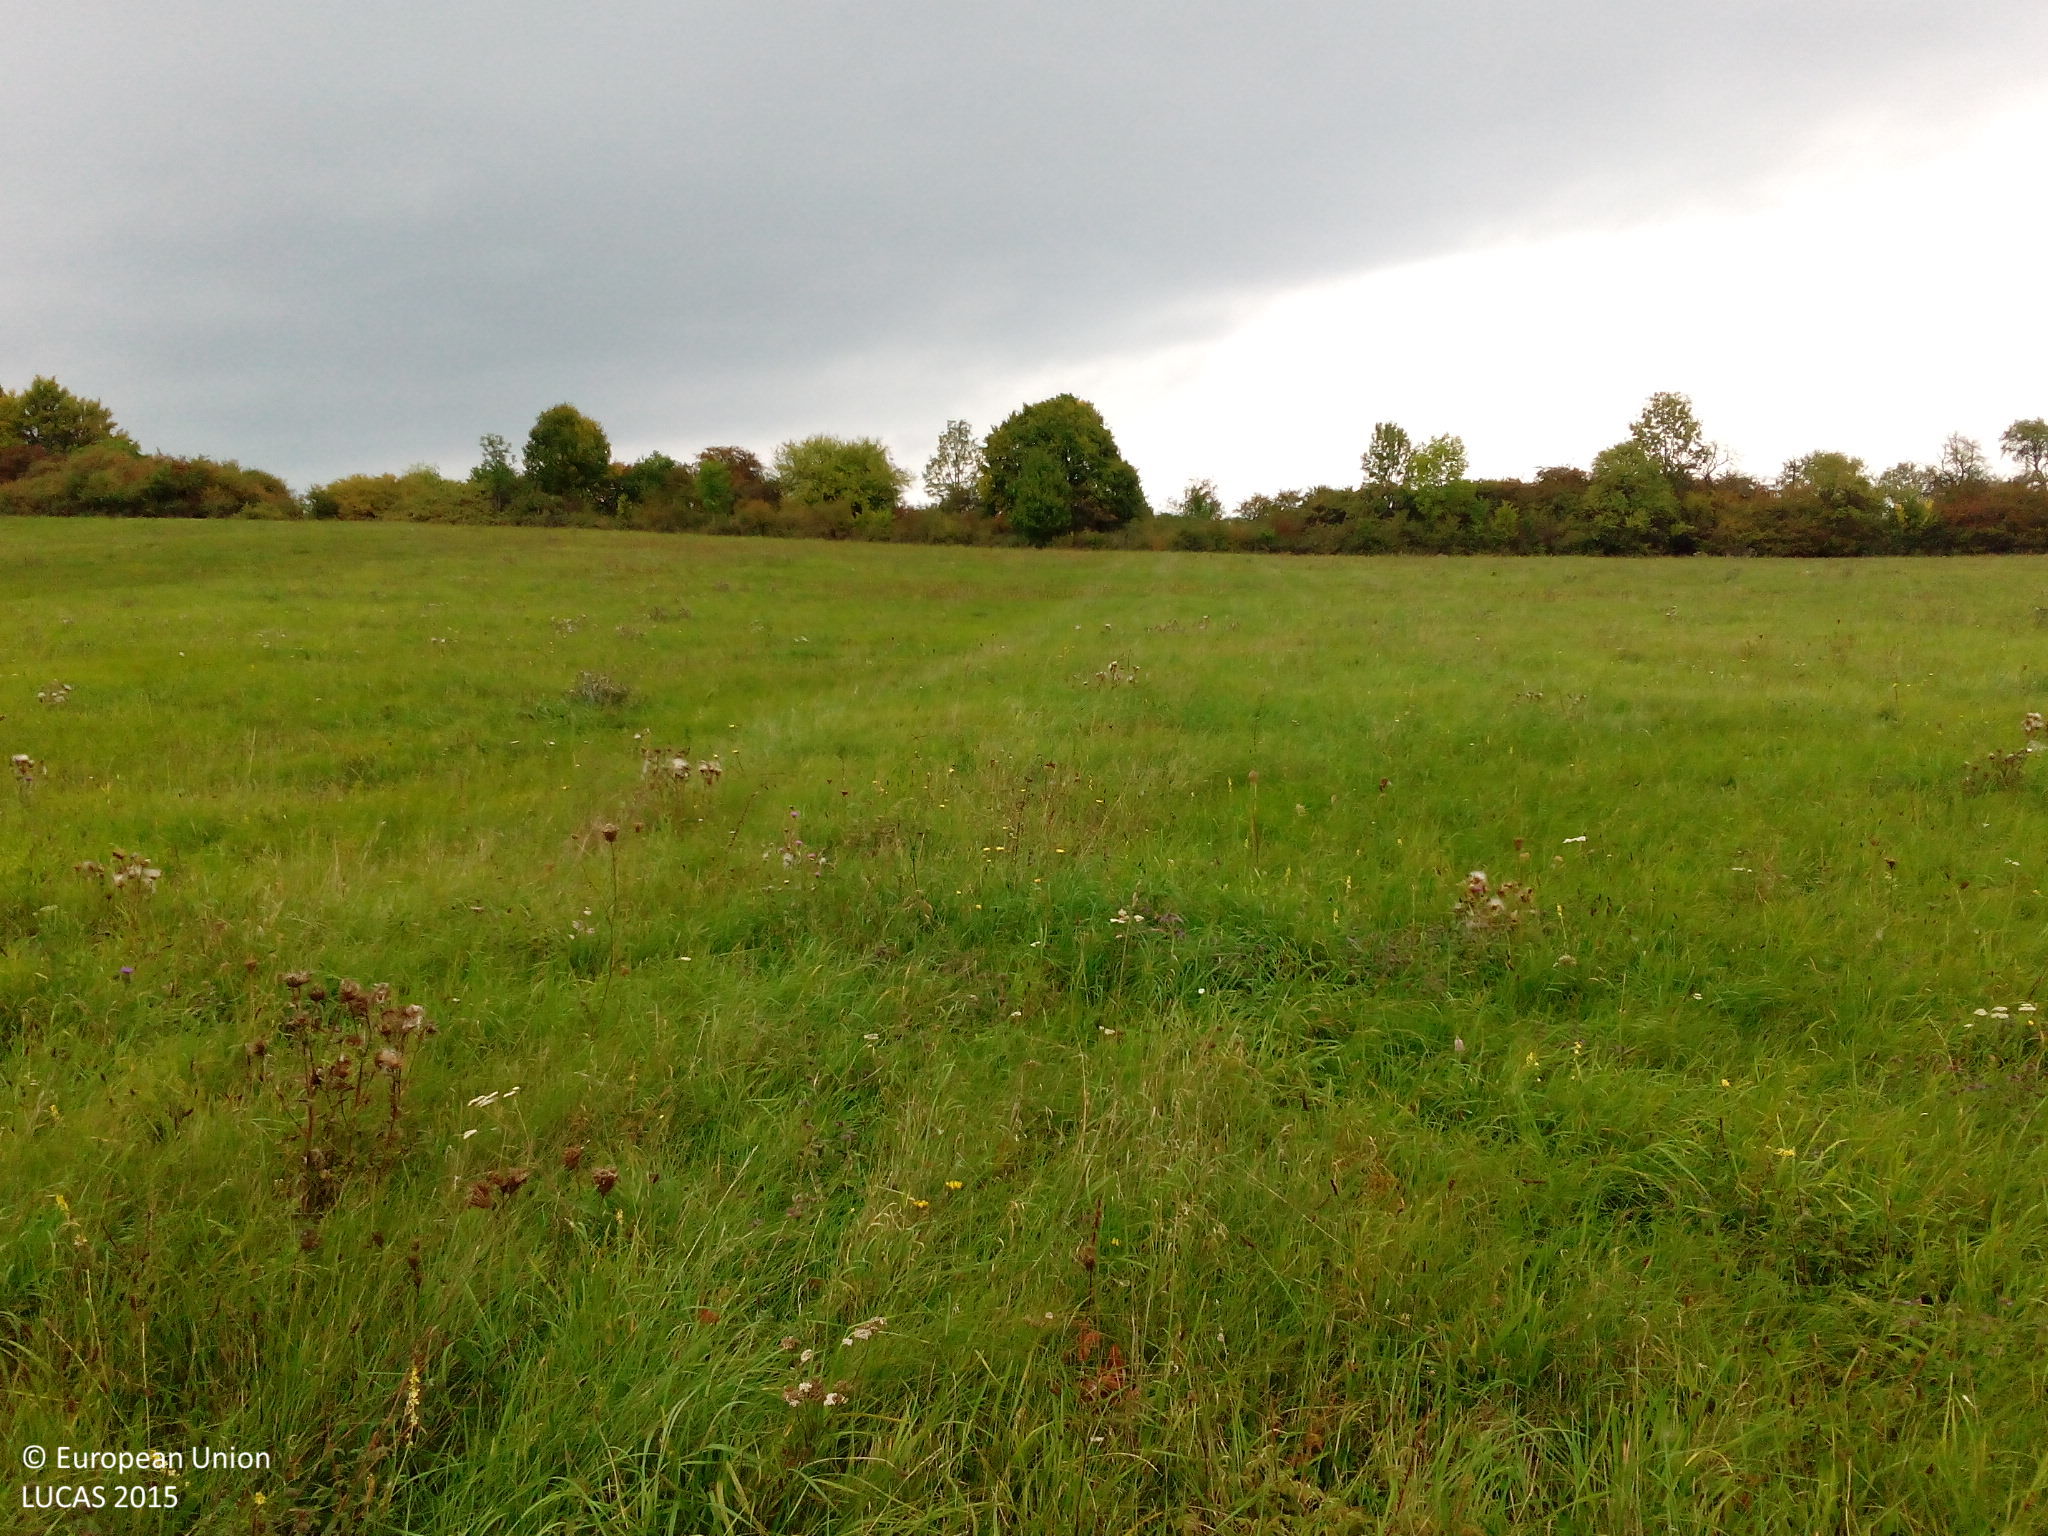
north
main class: Grassland
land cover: Grassland without tree/shrub cover
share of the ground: > 75 %
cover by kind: herbaceous plants 100 %
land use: Agriculture (excluding fallow land and kitchen gardens)
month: September
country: DE
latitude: 51.4922
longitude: 11.0223
